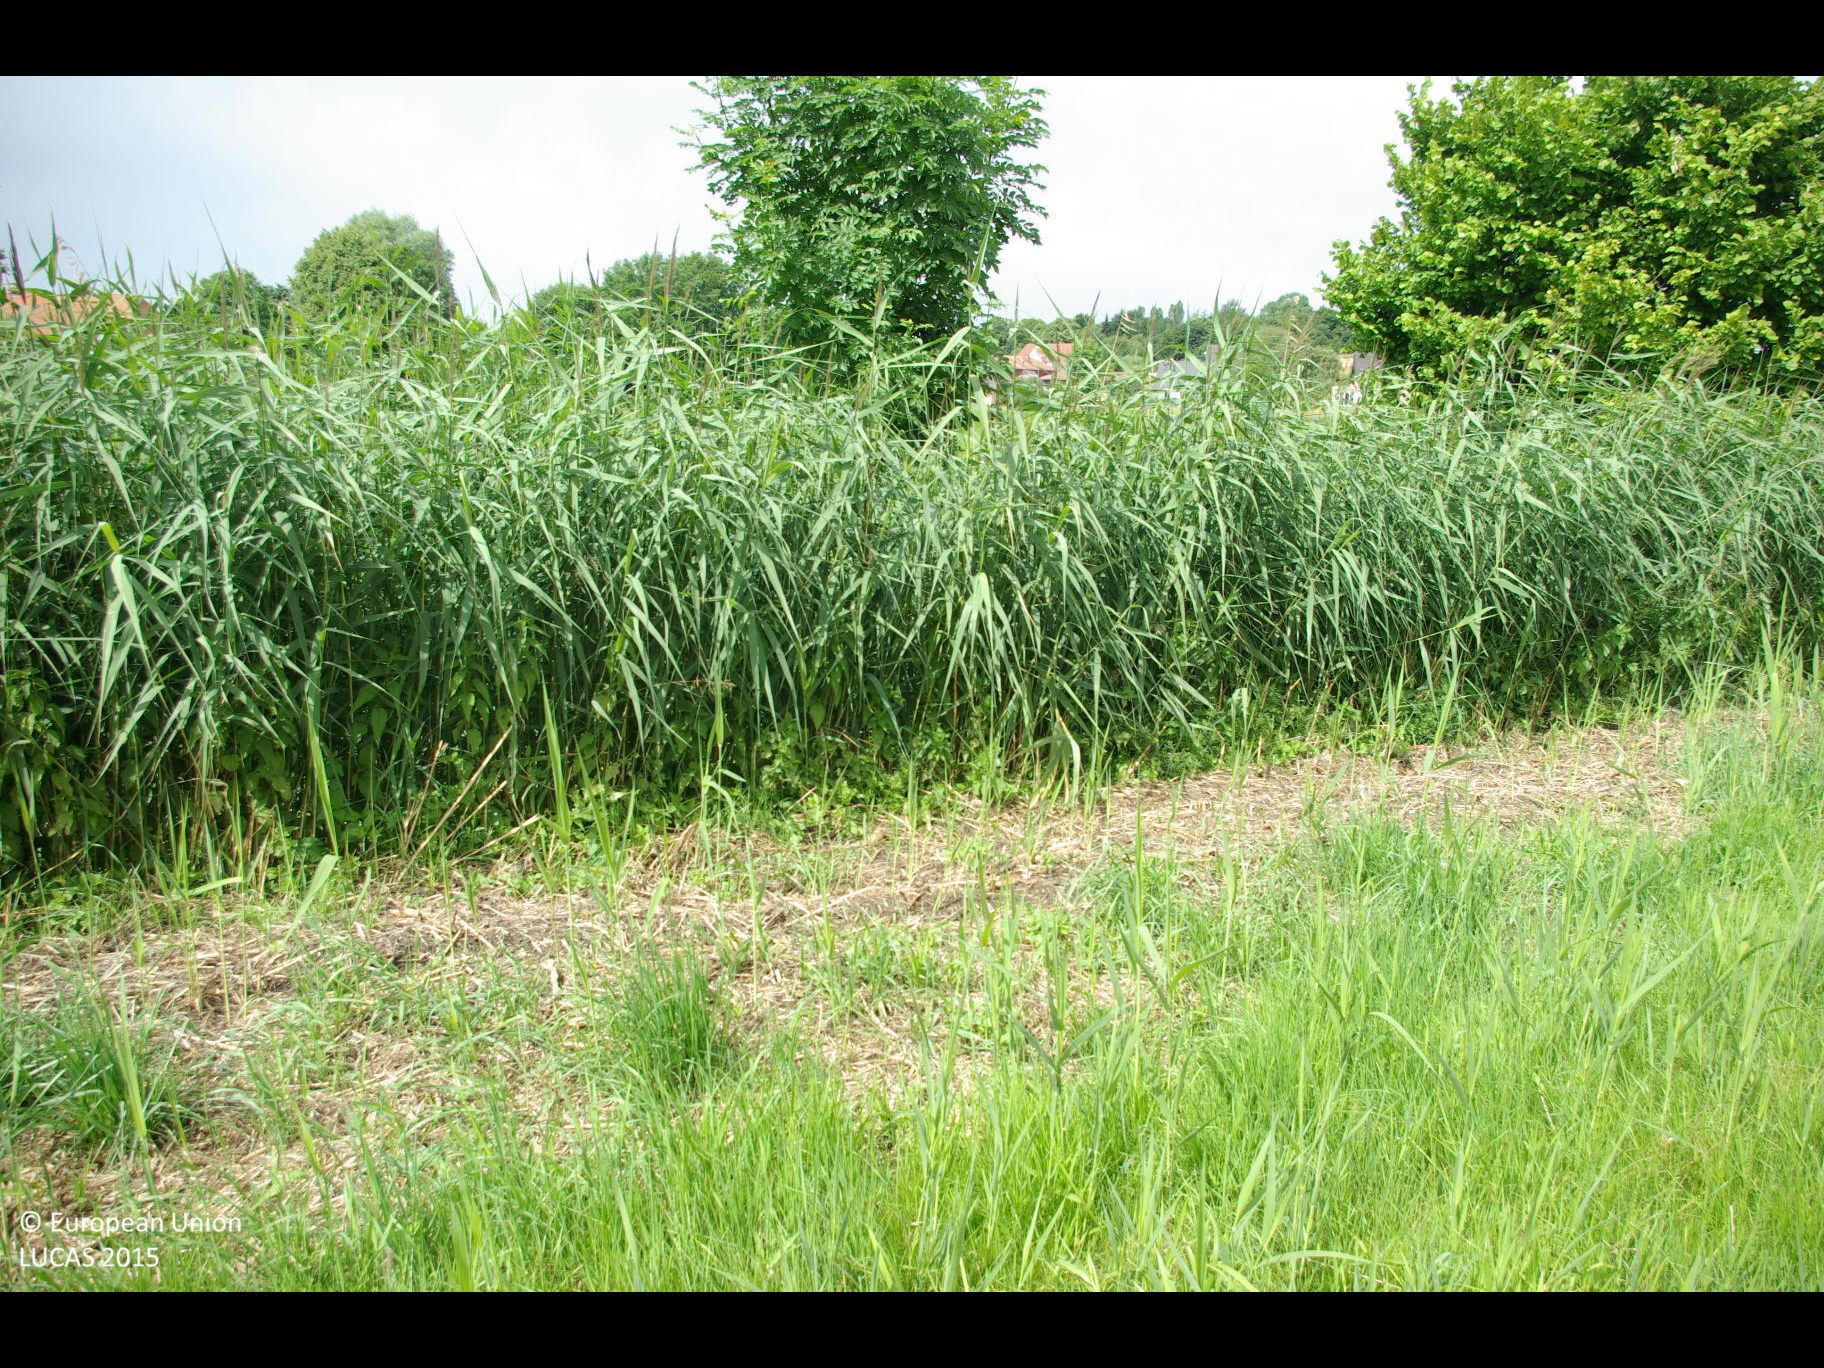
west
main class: Grassland
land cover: Grassland without tree/shrub cover
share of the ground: > 75 %
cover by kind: herbaceous plants 100 %
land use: Agriculture (excluding fallow land and kitchen gardens)
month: July
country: DE
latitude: 54.1551
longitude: 10.6274
